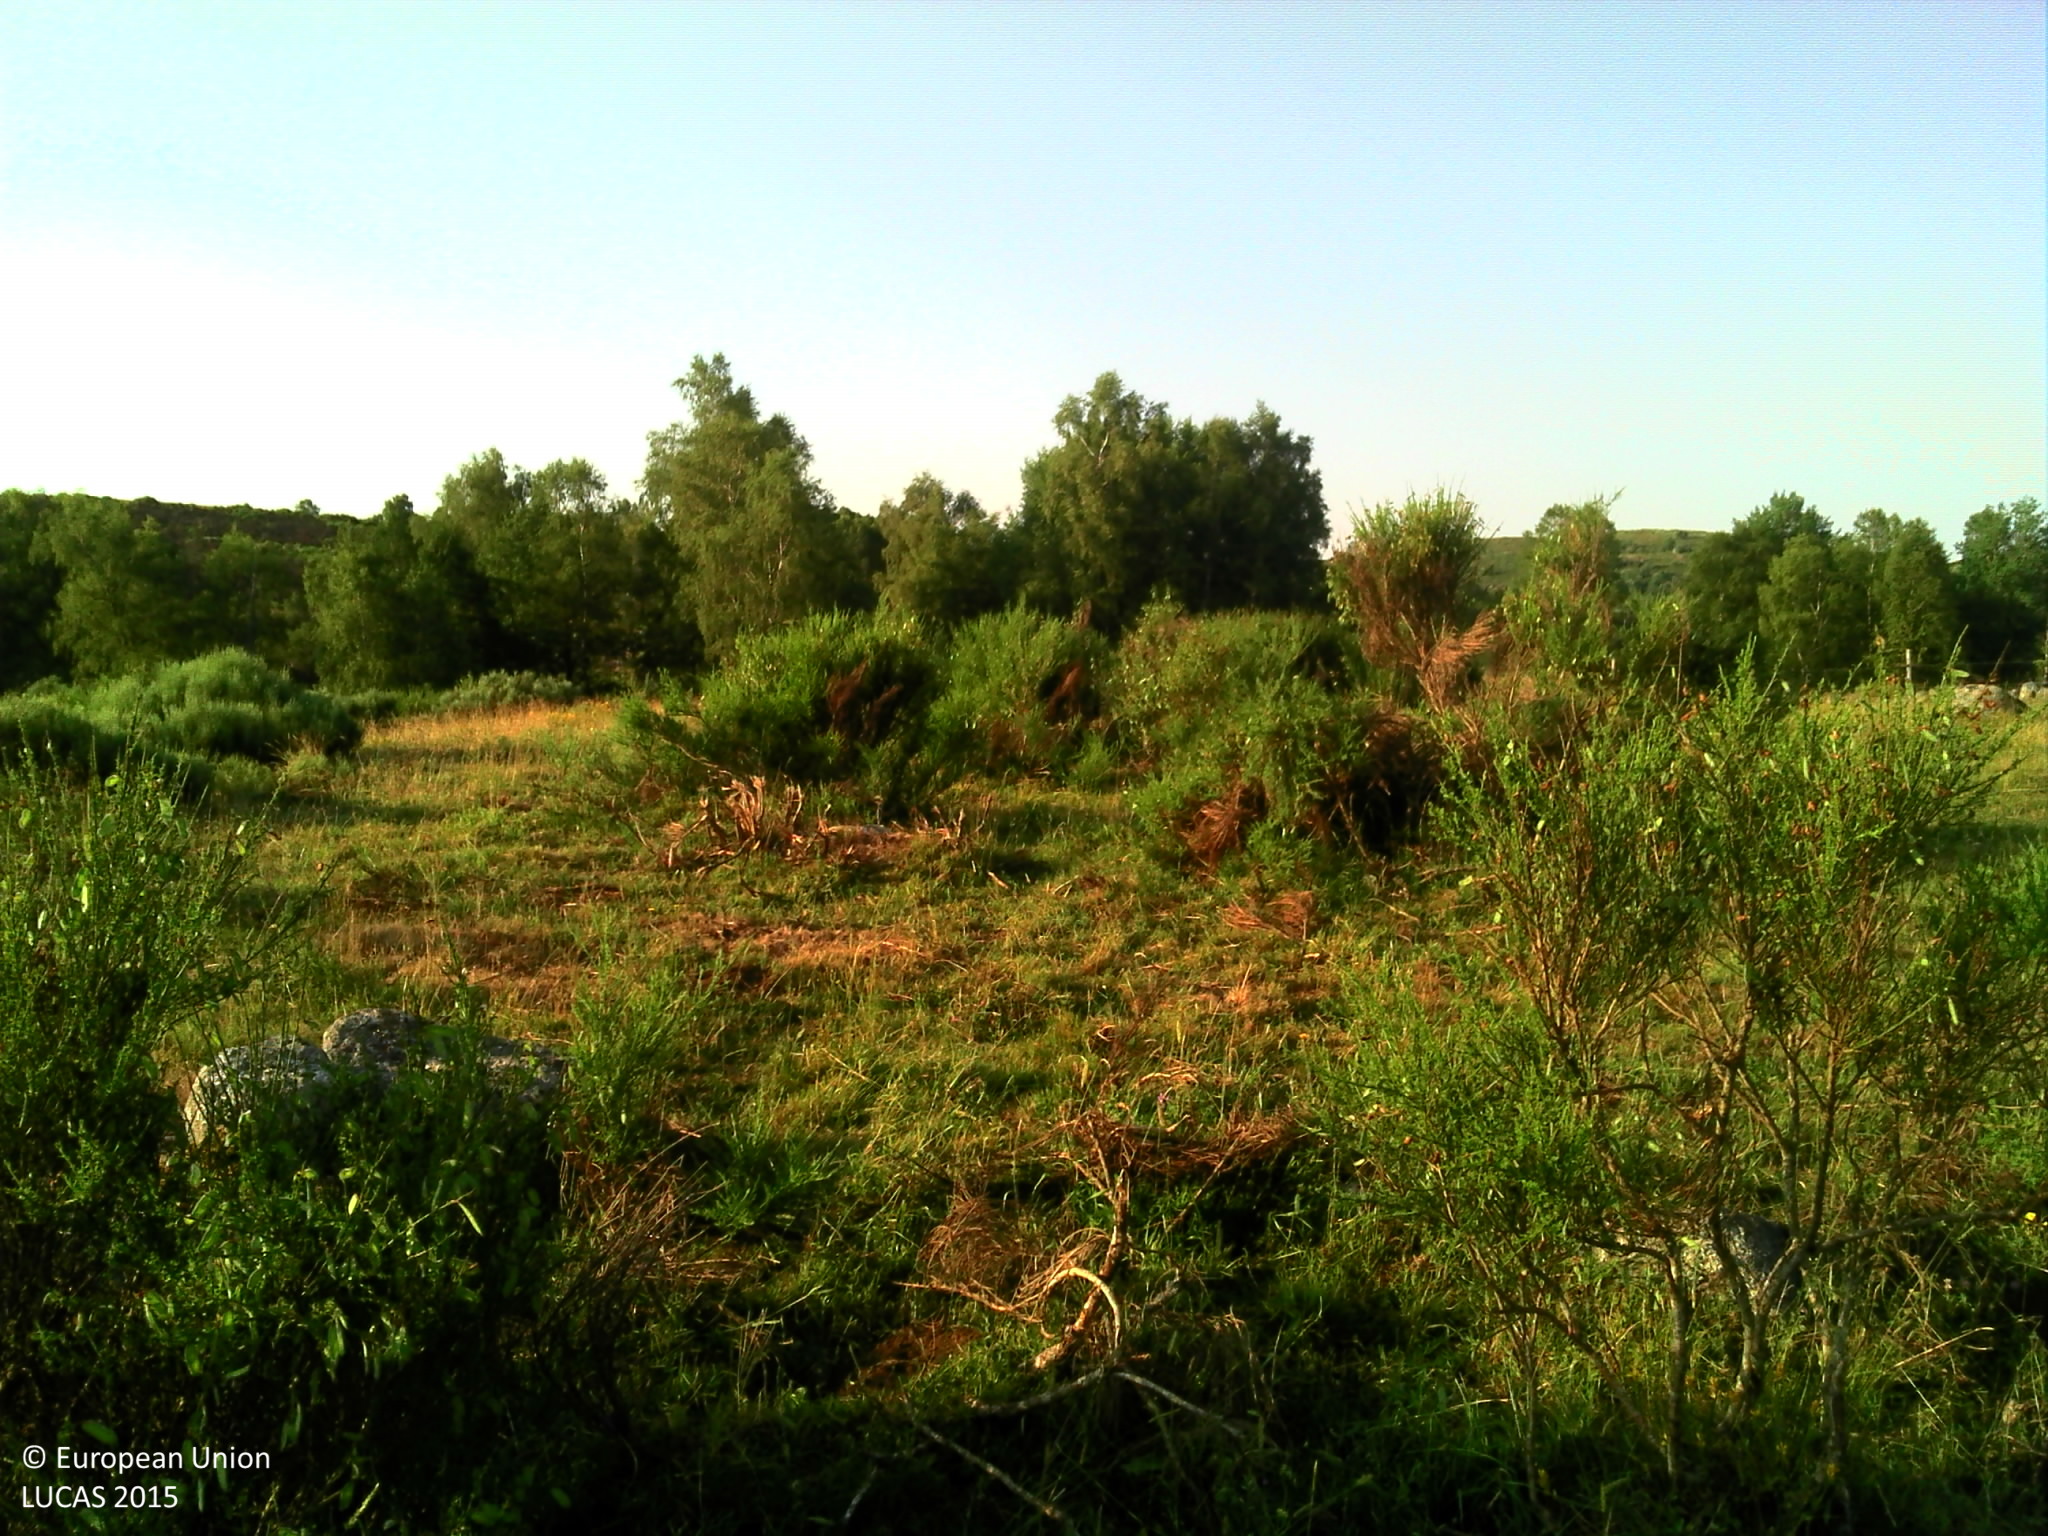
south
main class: Shrubland
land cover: Shrubland without tree cover
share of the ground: > 75 %
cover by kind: herbaceous plants 80 %, shrubs 20 %
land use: Agriculture (excluding fallow land and kitchen gardens)
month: July
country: FR
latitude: 44.7452
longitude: 2.9681
